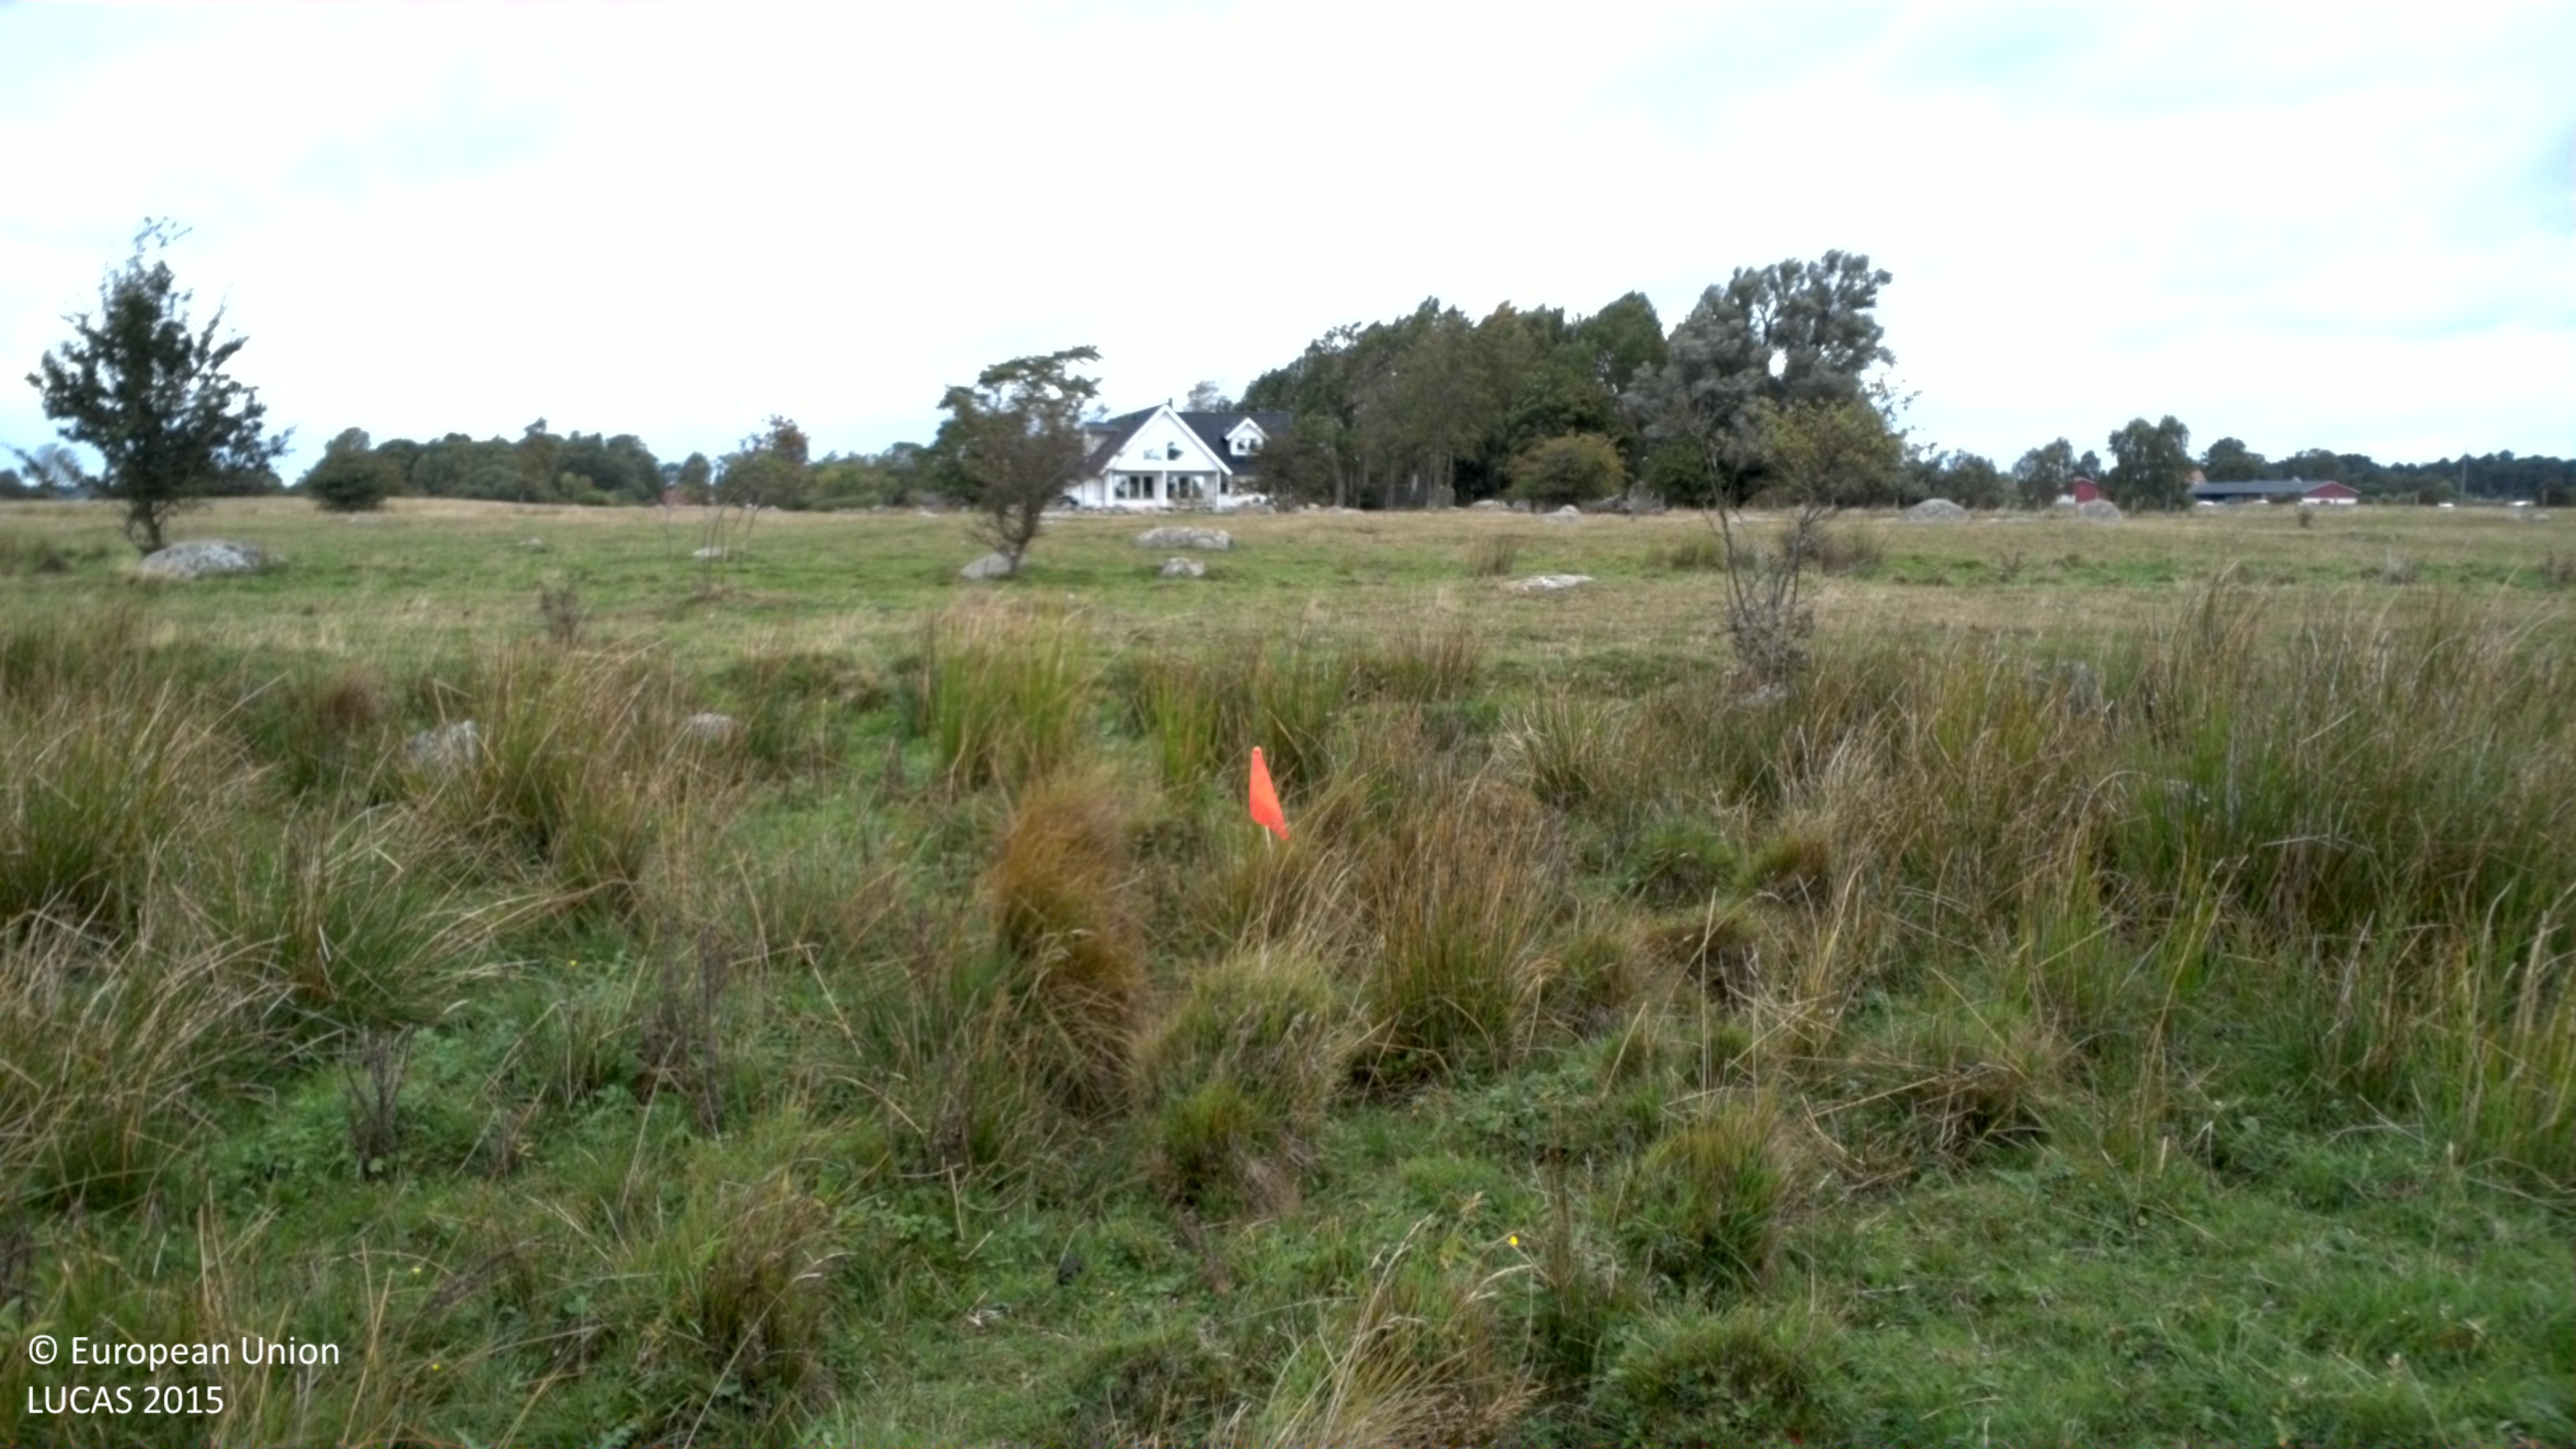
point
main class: Grassland
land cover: Grassland without tree/shrub cover
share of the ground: > 75 %
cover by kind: herbaceous plants 100 %
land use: Agriculture (excluding fallow land and kitchen gardens)
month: September
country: SE
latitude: 56.0030
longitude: 14.4402
